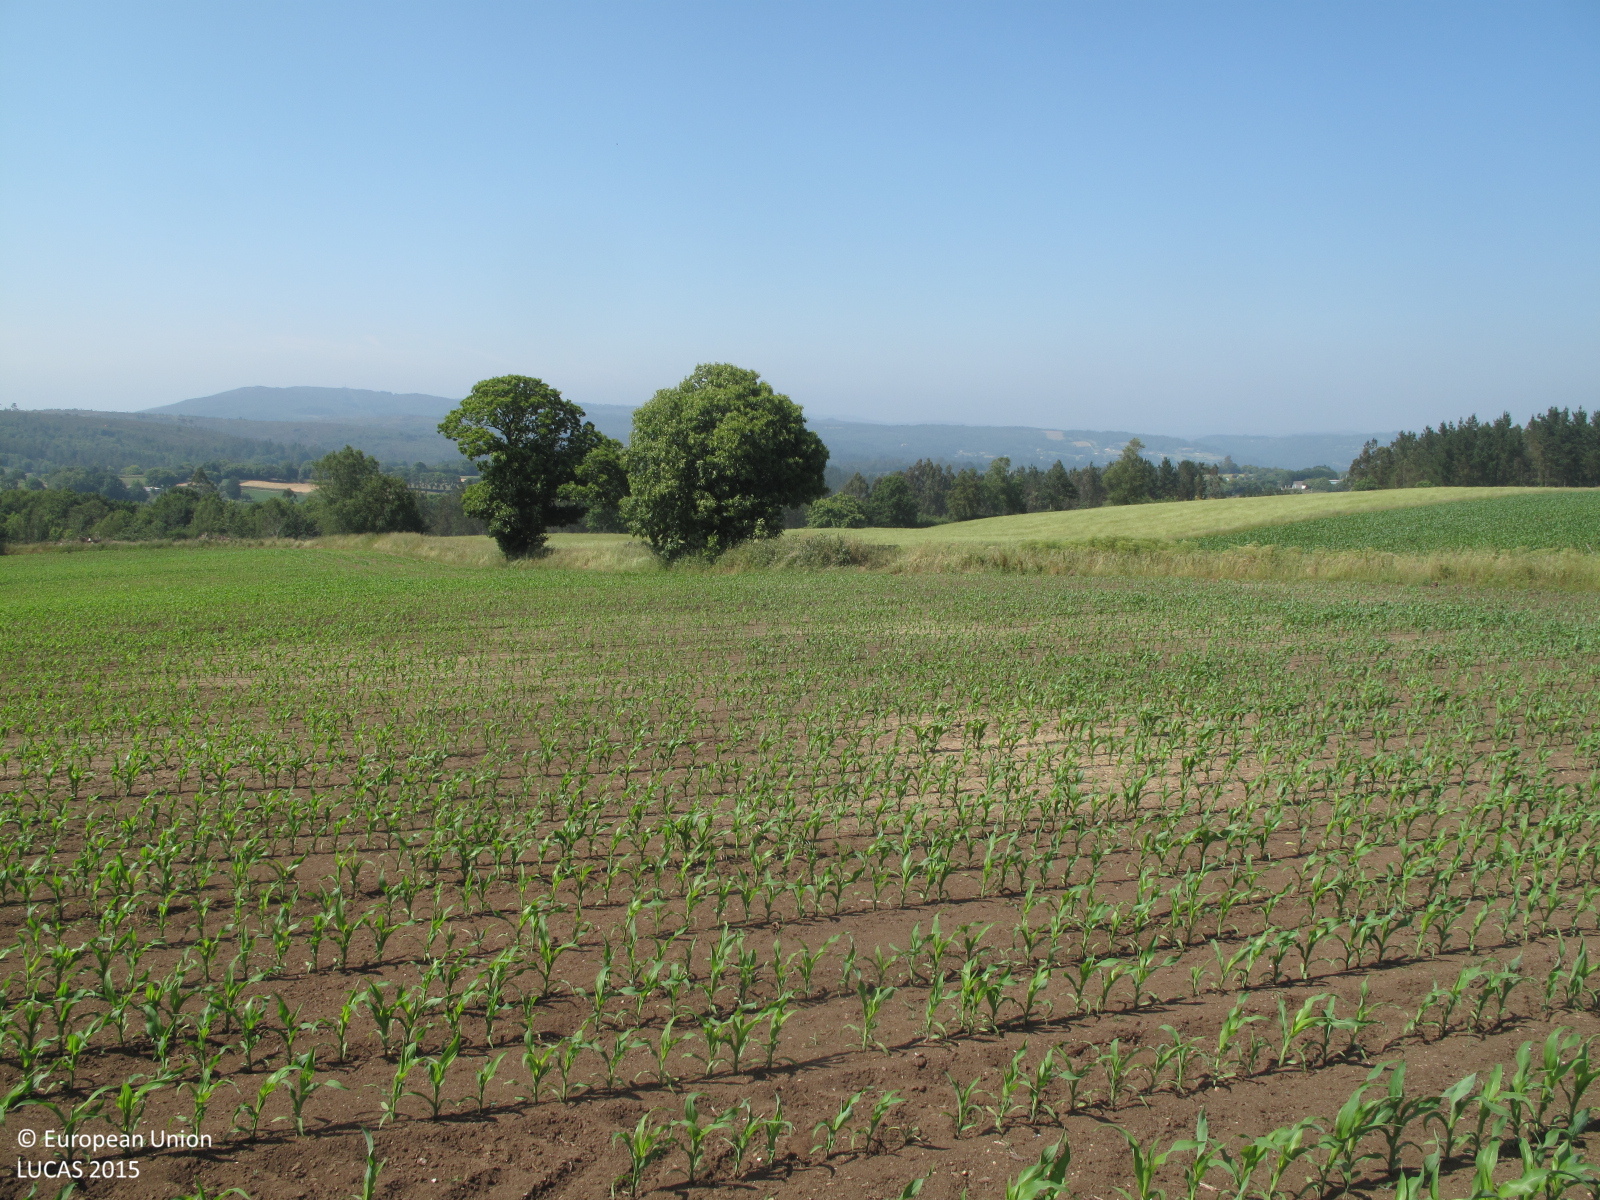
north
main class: Cropland
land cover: Maize
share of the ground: 10 - 25 %
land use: Agriculture (excluding fallow land and kitchen gardens)
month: June
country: ES
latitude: 43.2817
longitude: -7.9735
